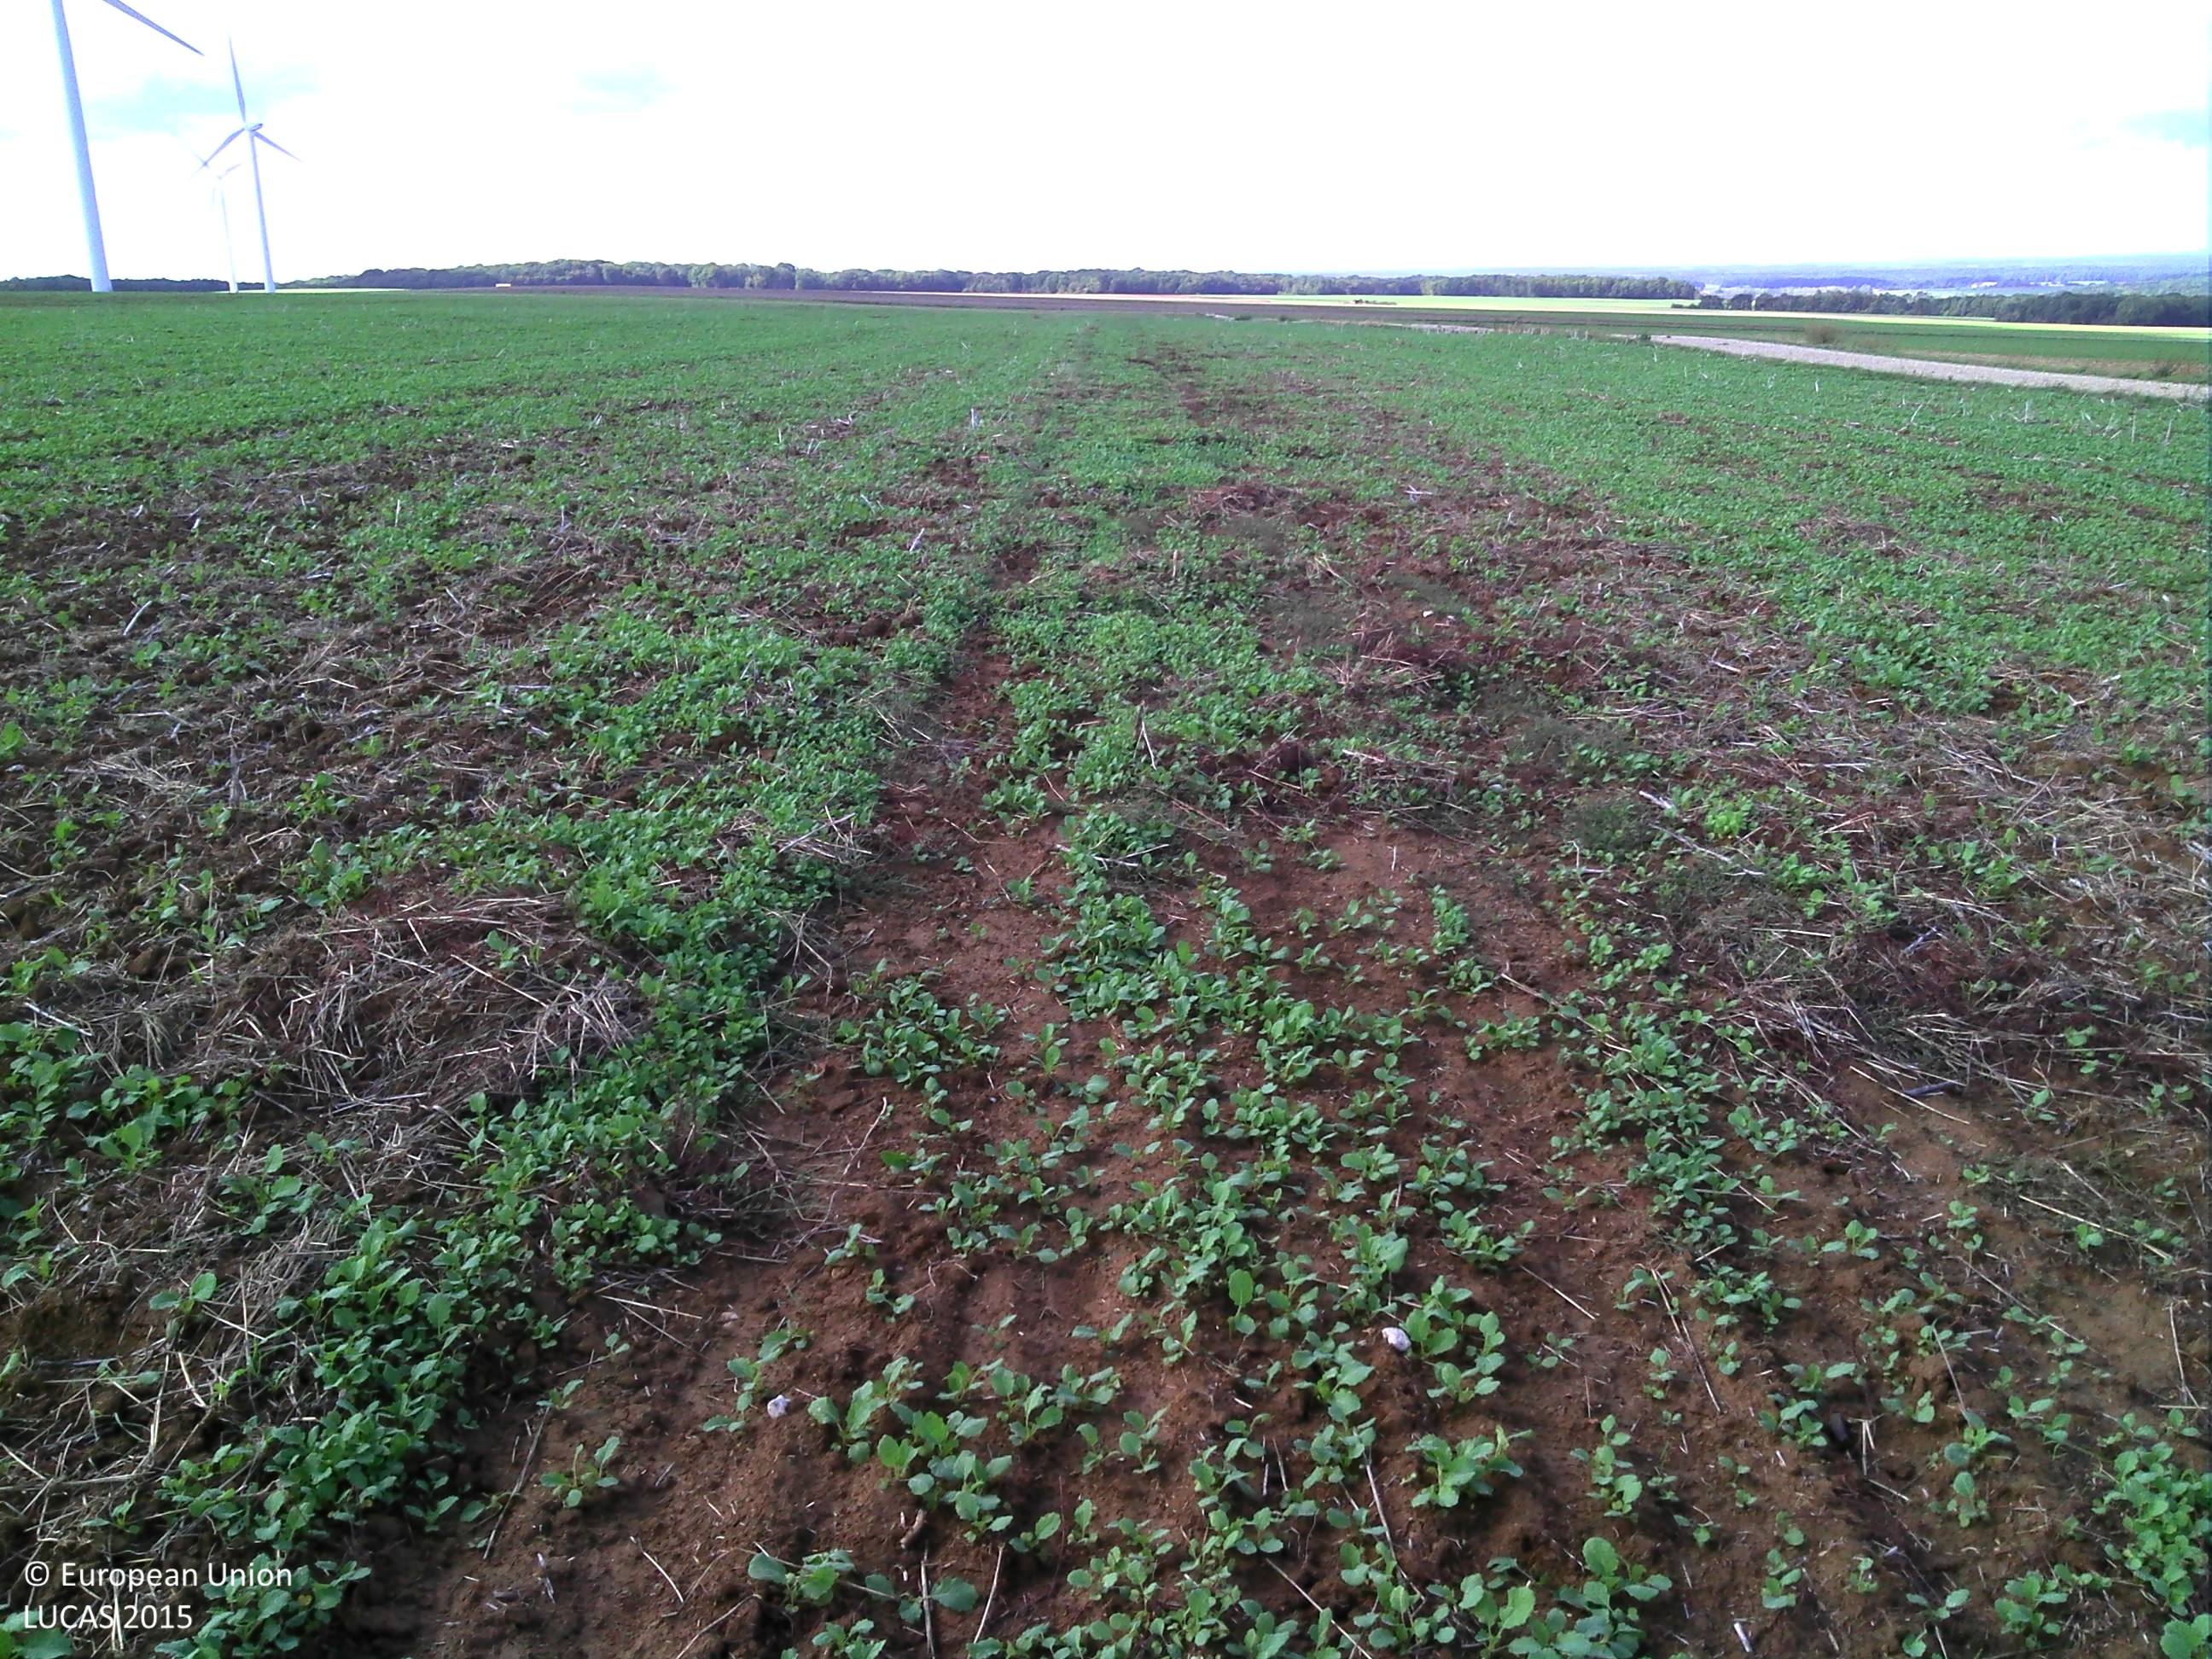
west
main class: Cropland
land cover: Rape and turnip rape
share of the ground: 10 - 25 %
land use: Agriculture (excluding fallow land and kitchen gardens)
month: September
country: FR
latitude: 48.2945
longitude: 4.7007
